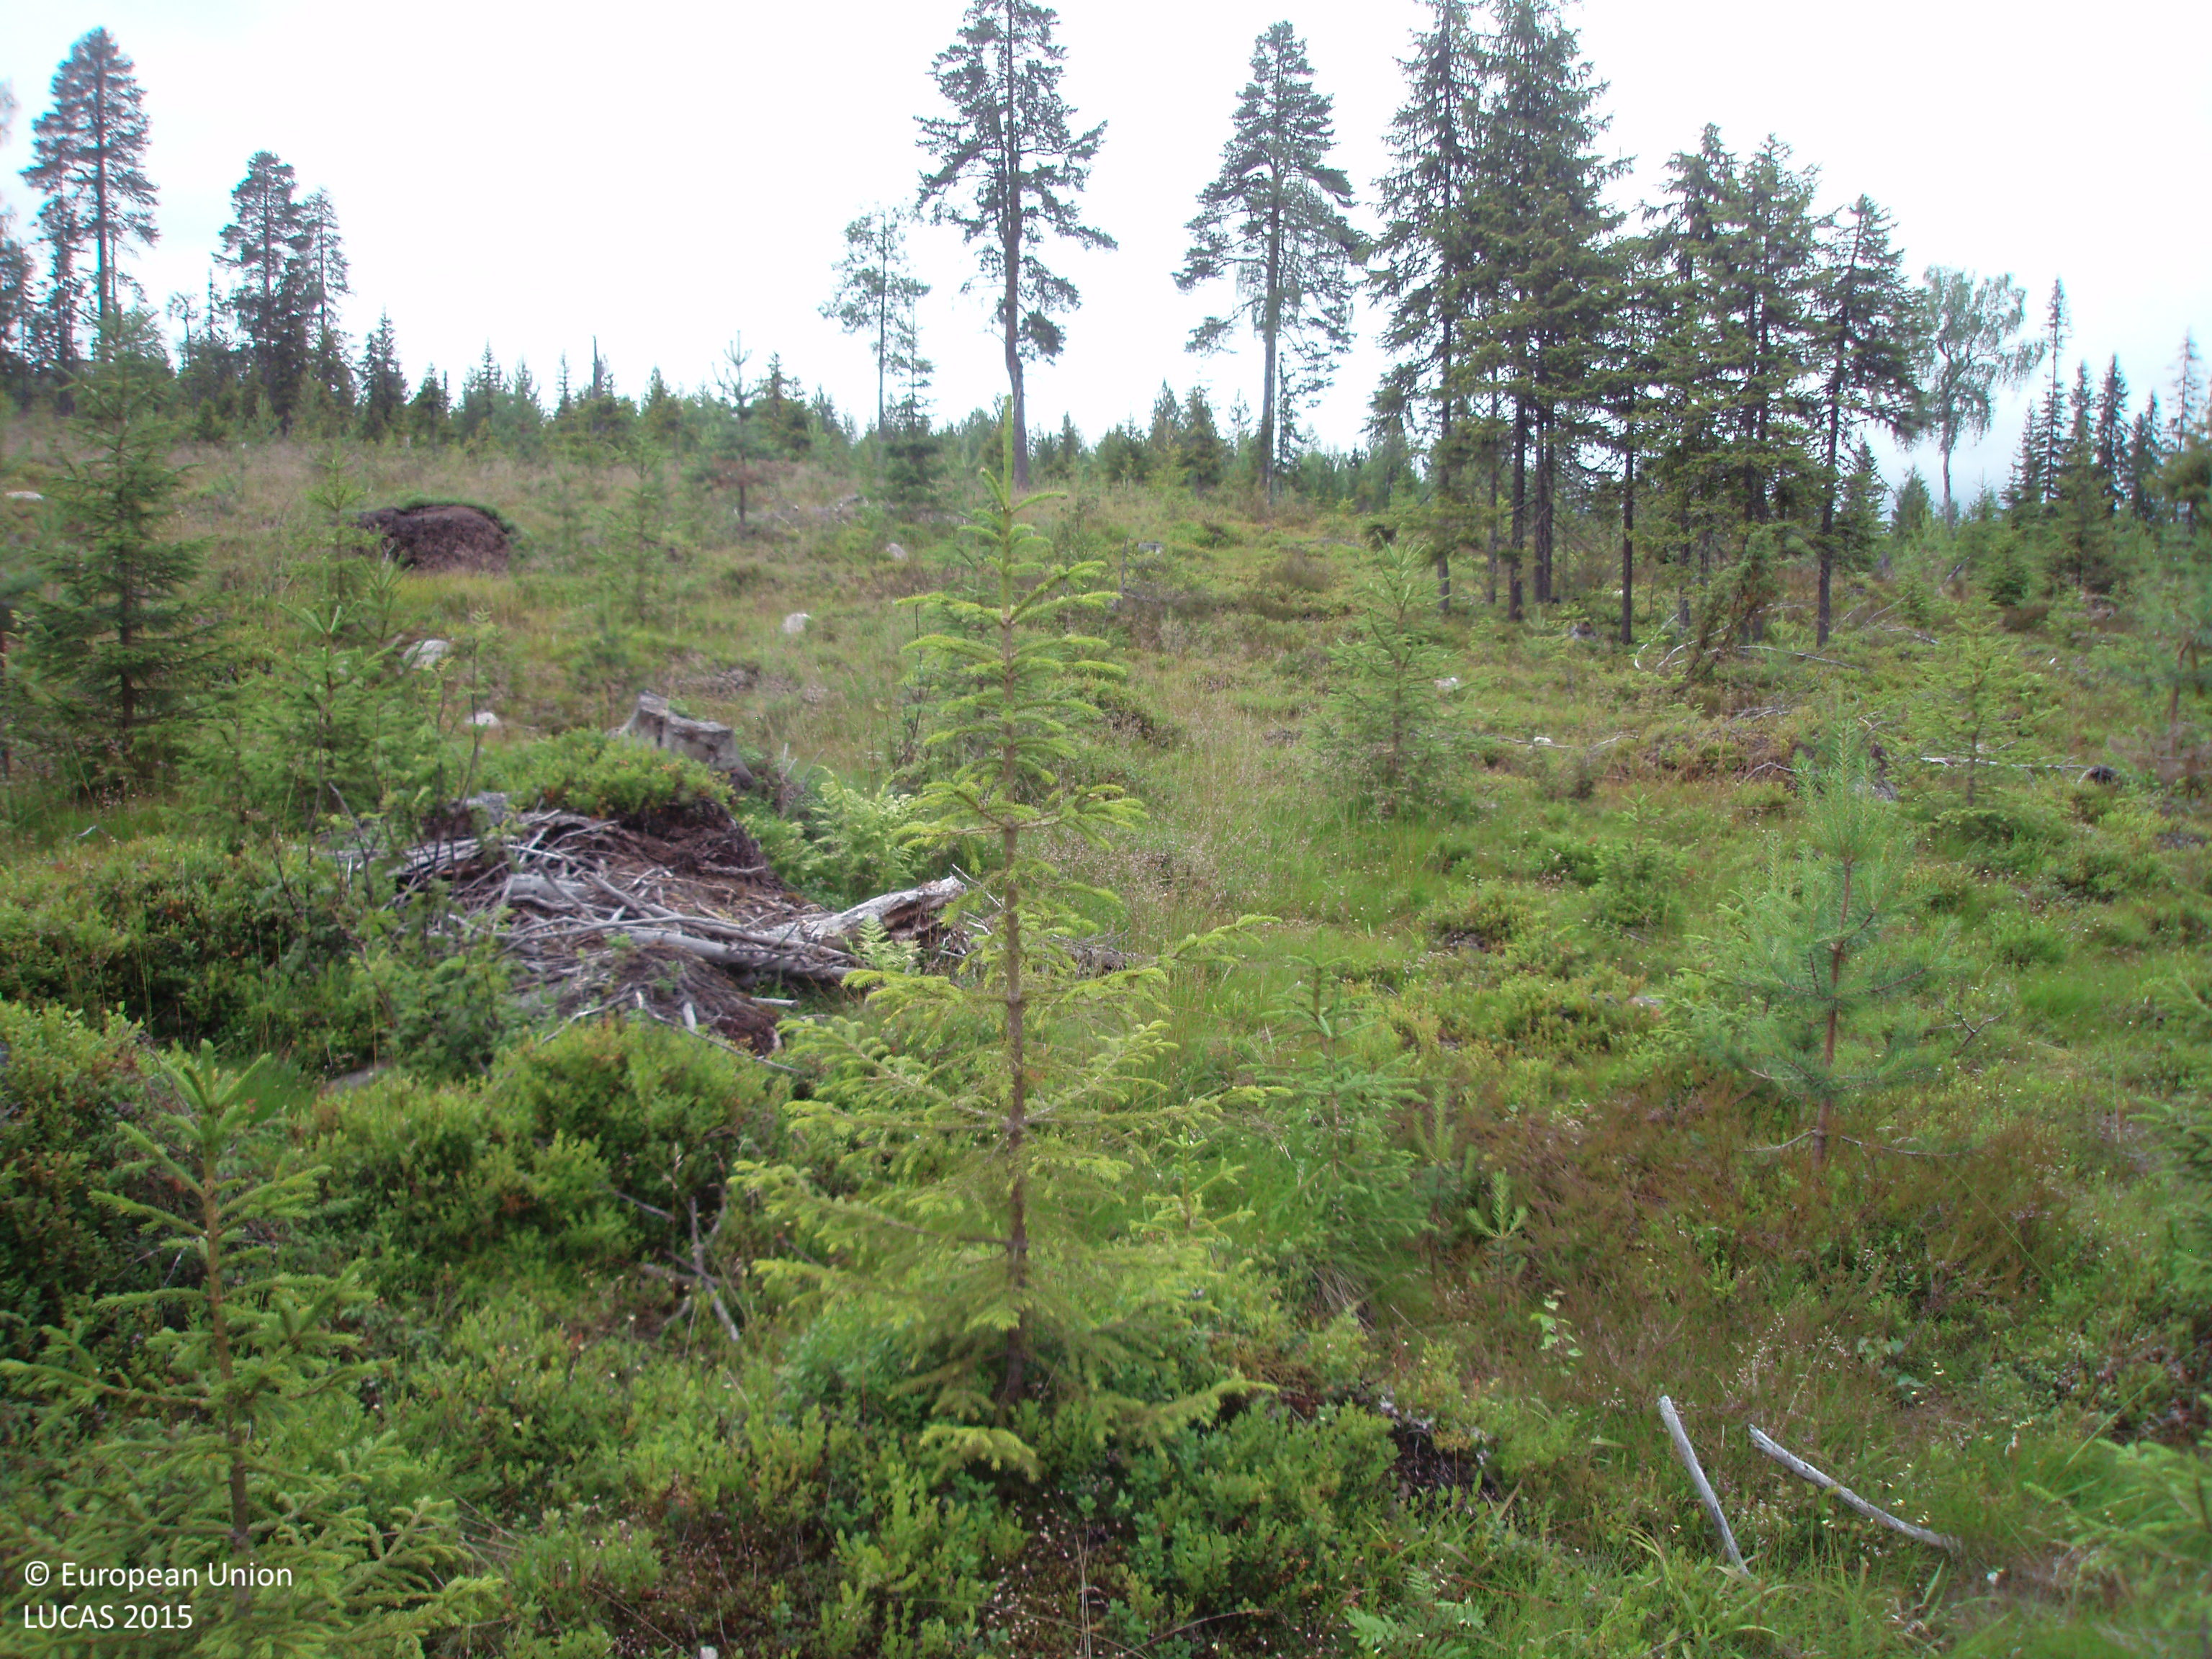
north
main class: Shrubland
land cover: Shrubland with sparse tree cover
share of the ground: 50 - 75 %
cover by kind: shrubs 60 %, herbaceous plants 30 %, coniferous forest trees 5 %, consolidated bare surface 5 %
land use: Forestry
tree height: < 5 m
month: July
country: FI
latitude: 65.5652
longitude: 27.7498
